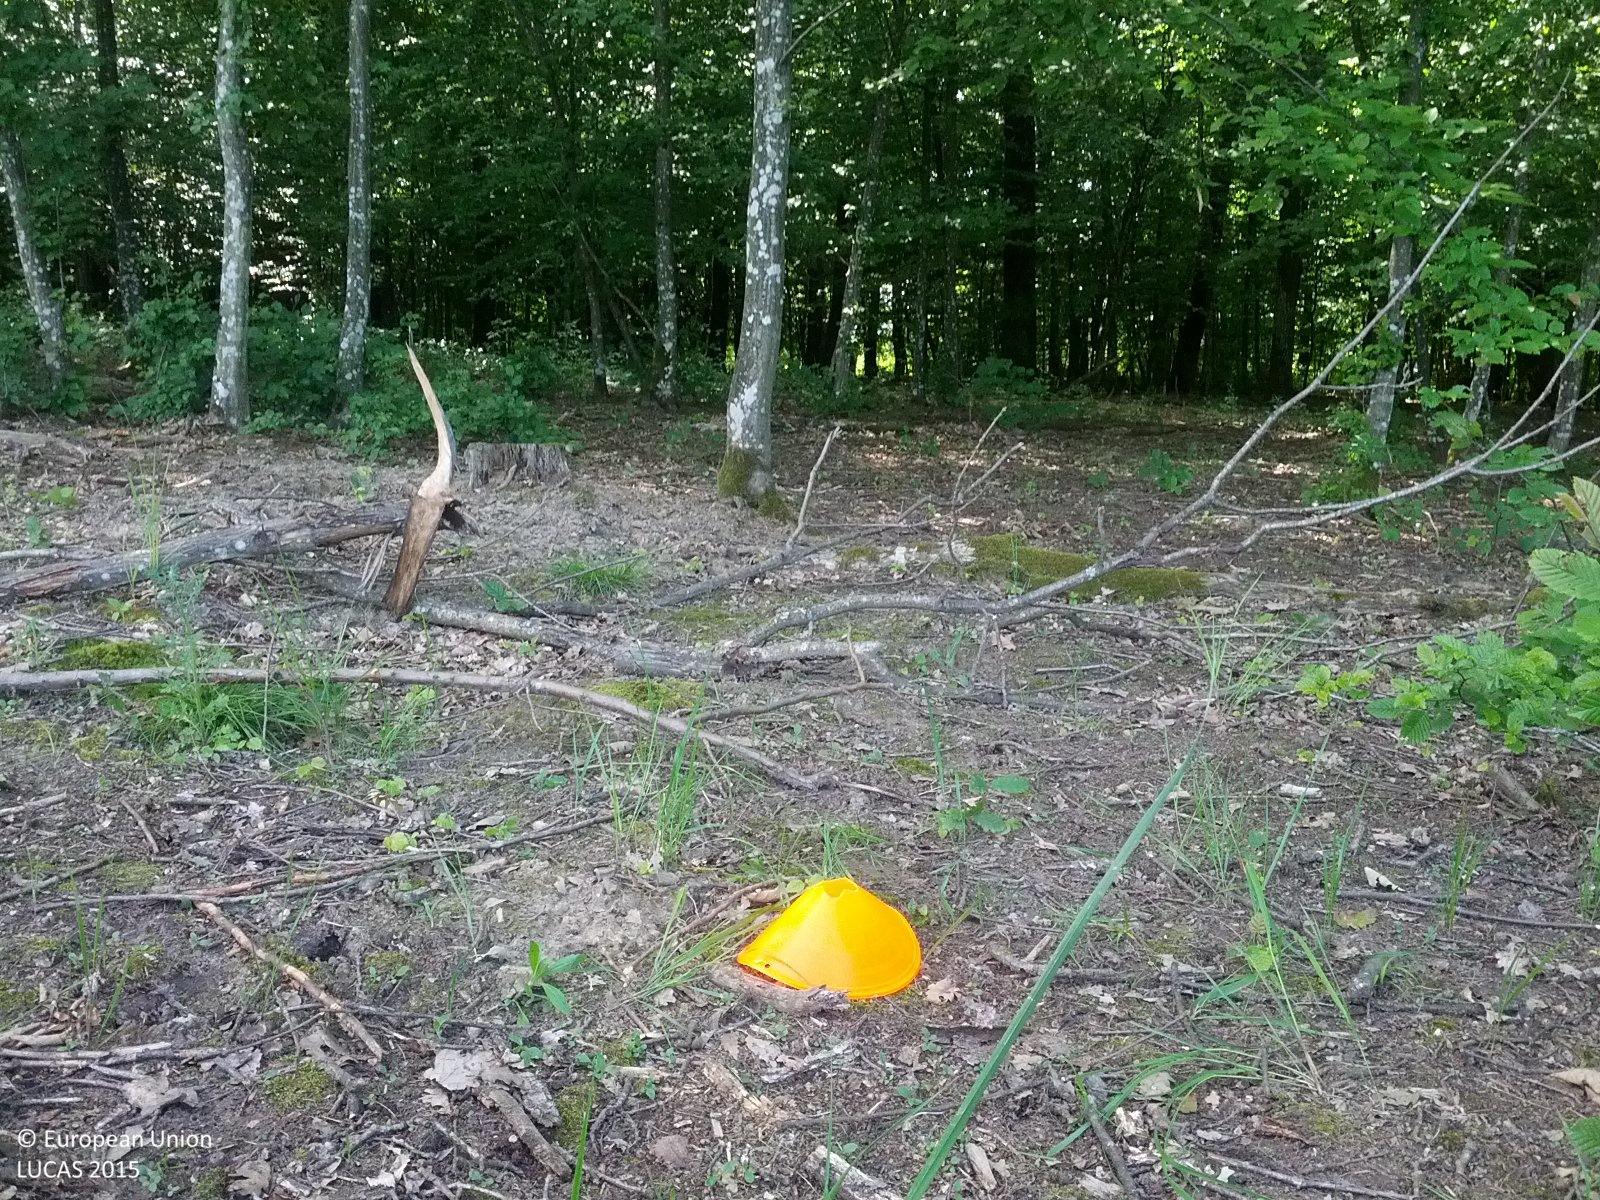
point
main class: Woodland
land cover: Broadleaved woodland
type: beech forest
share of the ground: 50 - 75 %
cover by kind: broadleaved forest trees 60 %, unconsolidated bare surface 20 %, herbaceous plants 15 %, shrubs 5 %
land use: Forestry
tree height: > 5 m
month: June
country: AT
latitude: 47.0992
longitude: 16.3925
